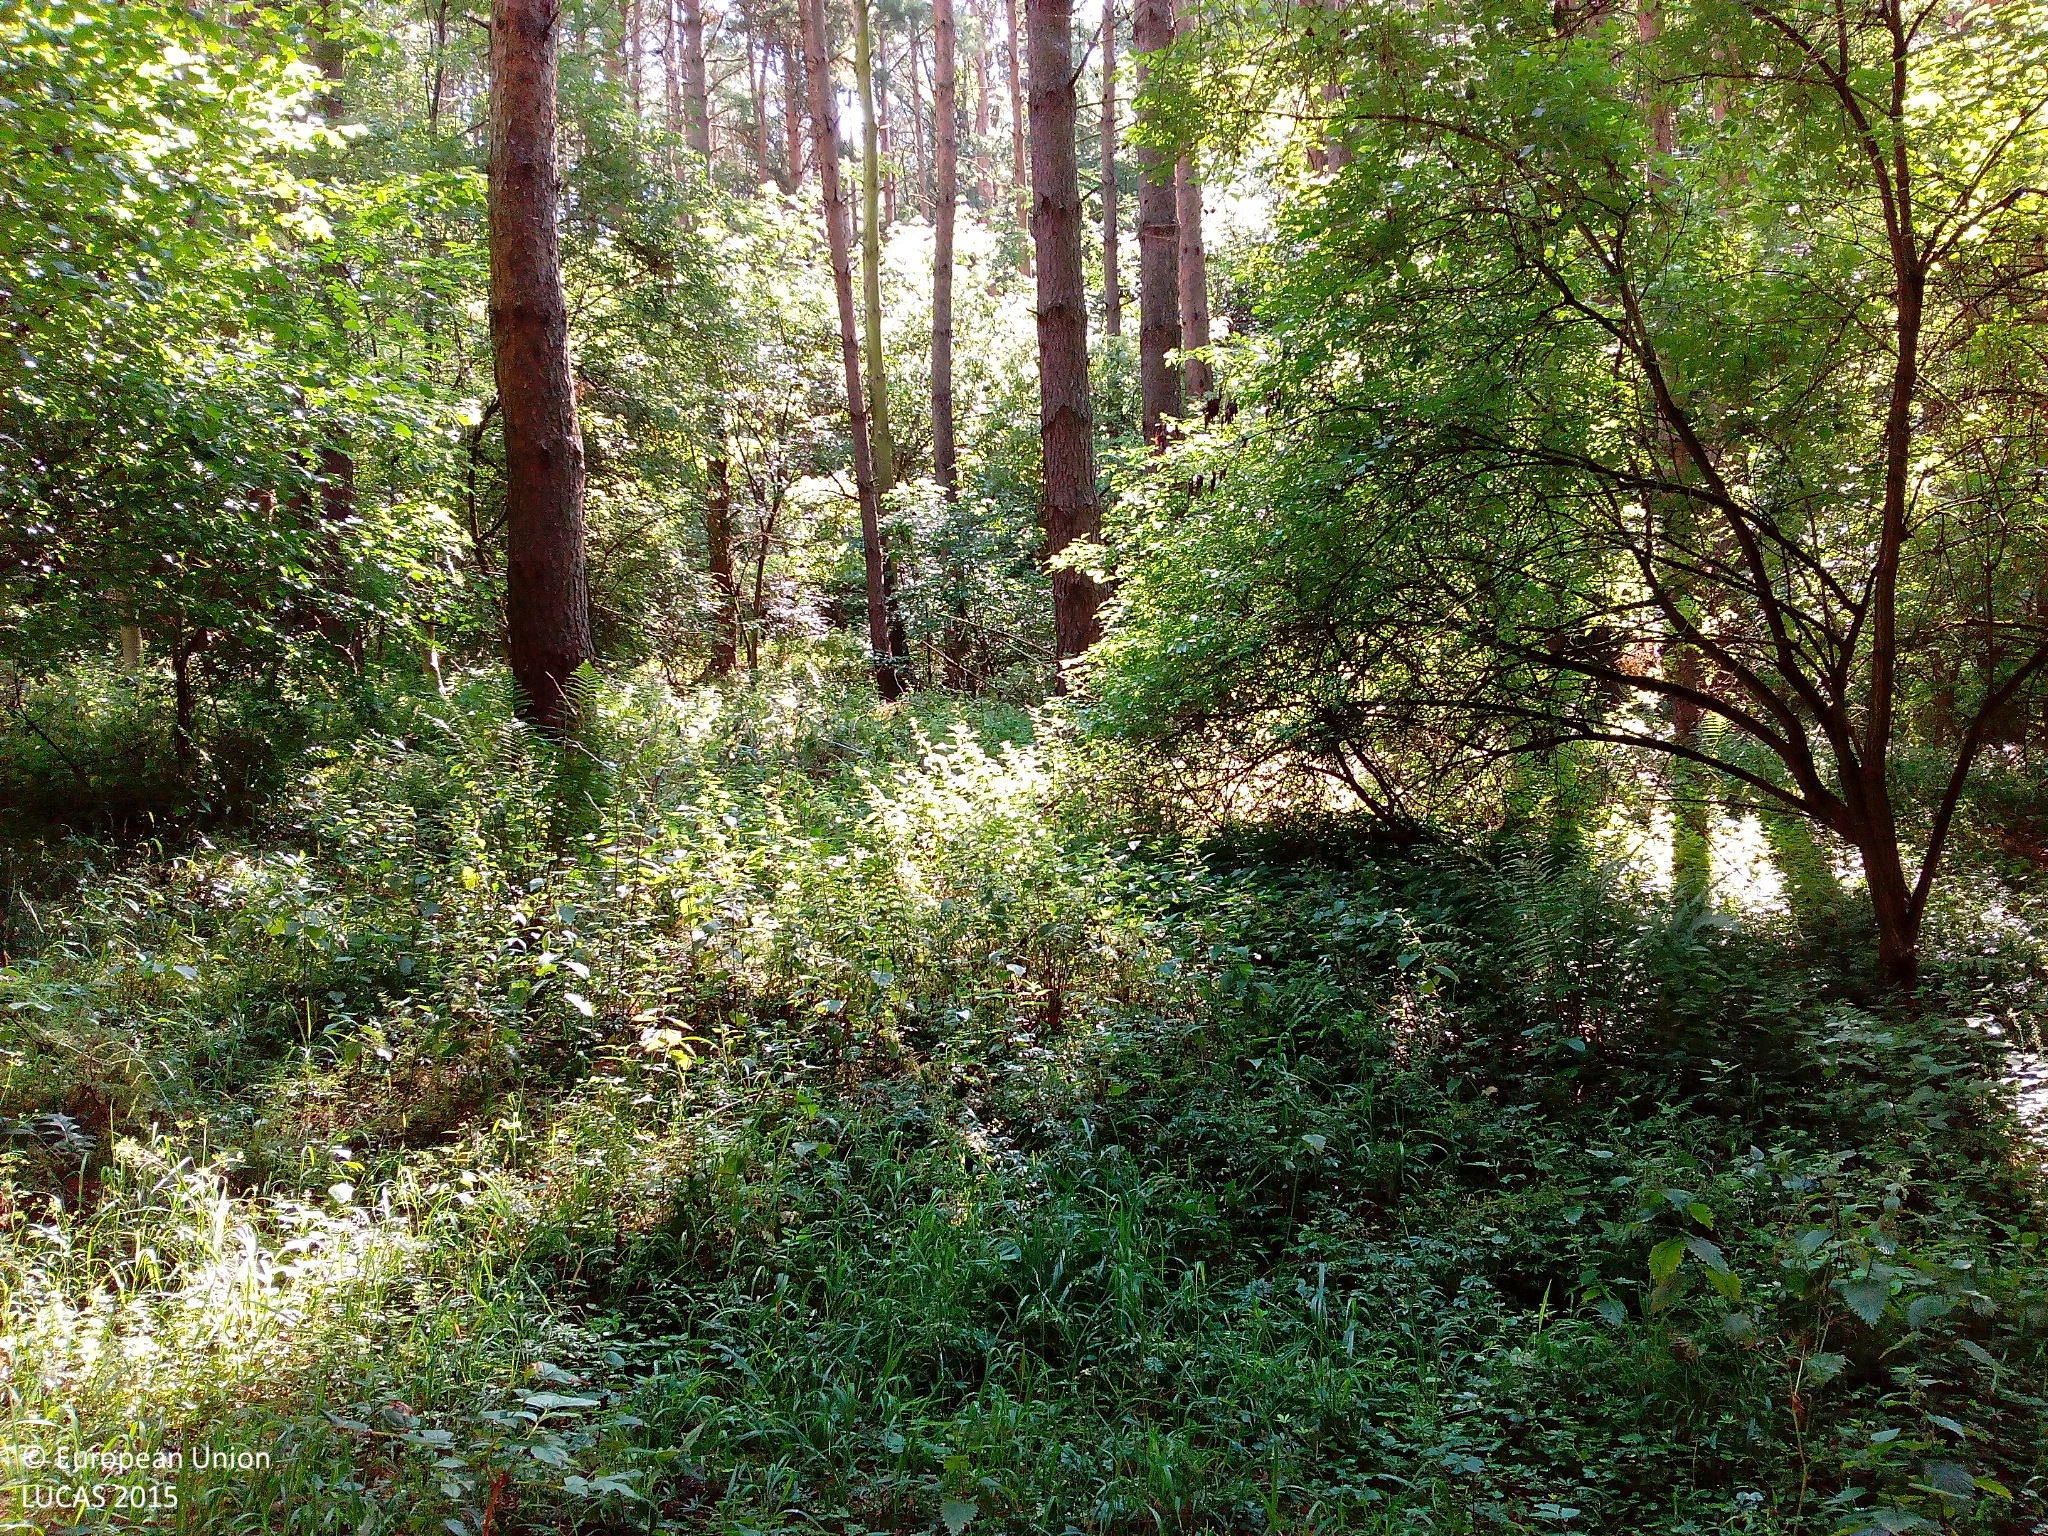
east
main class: Woodland
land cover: Spruce dominated coniferous woodland
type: hemiboreal forest and nemoral coniferous forest and mixed broadleaved-coniferous forest
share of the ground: > 75 %
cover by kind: coniferous forest trees 90 %, broadleaved forest trees 5 %, herbaceous plants 5 %
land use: Forestry
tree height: > 5 m
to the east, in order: Spruce dominated coniferous woodland; Pine dominated mixed woodland; Tracks
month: July
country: DE
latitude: 50.6517
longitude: 9.9576
